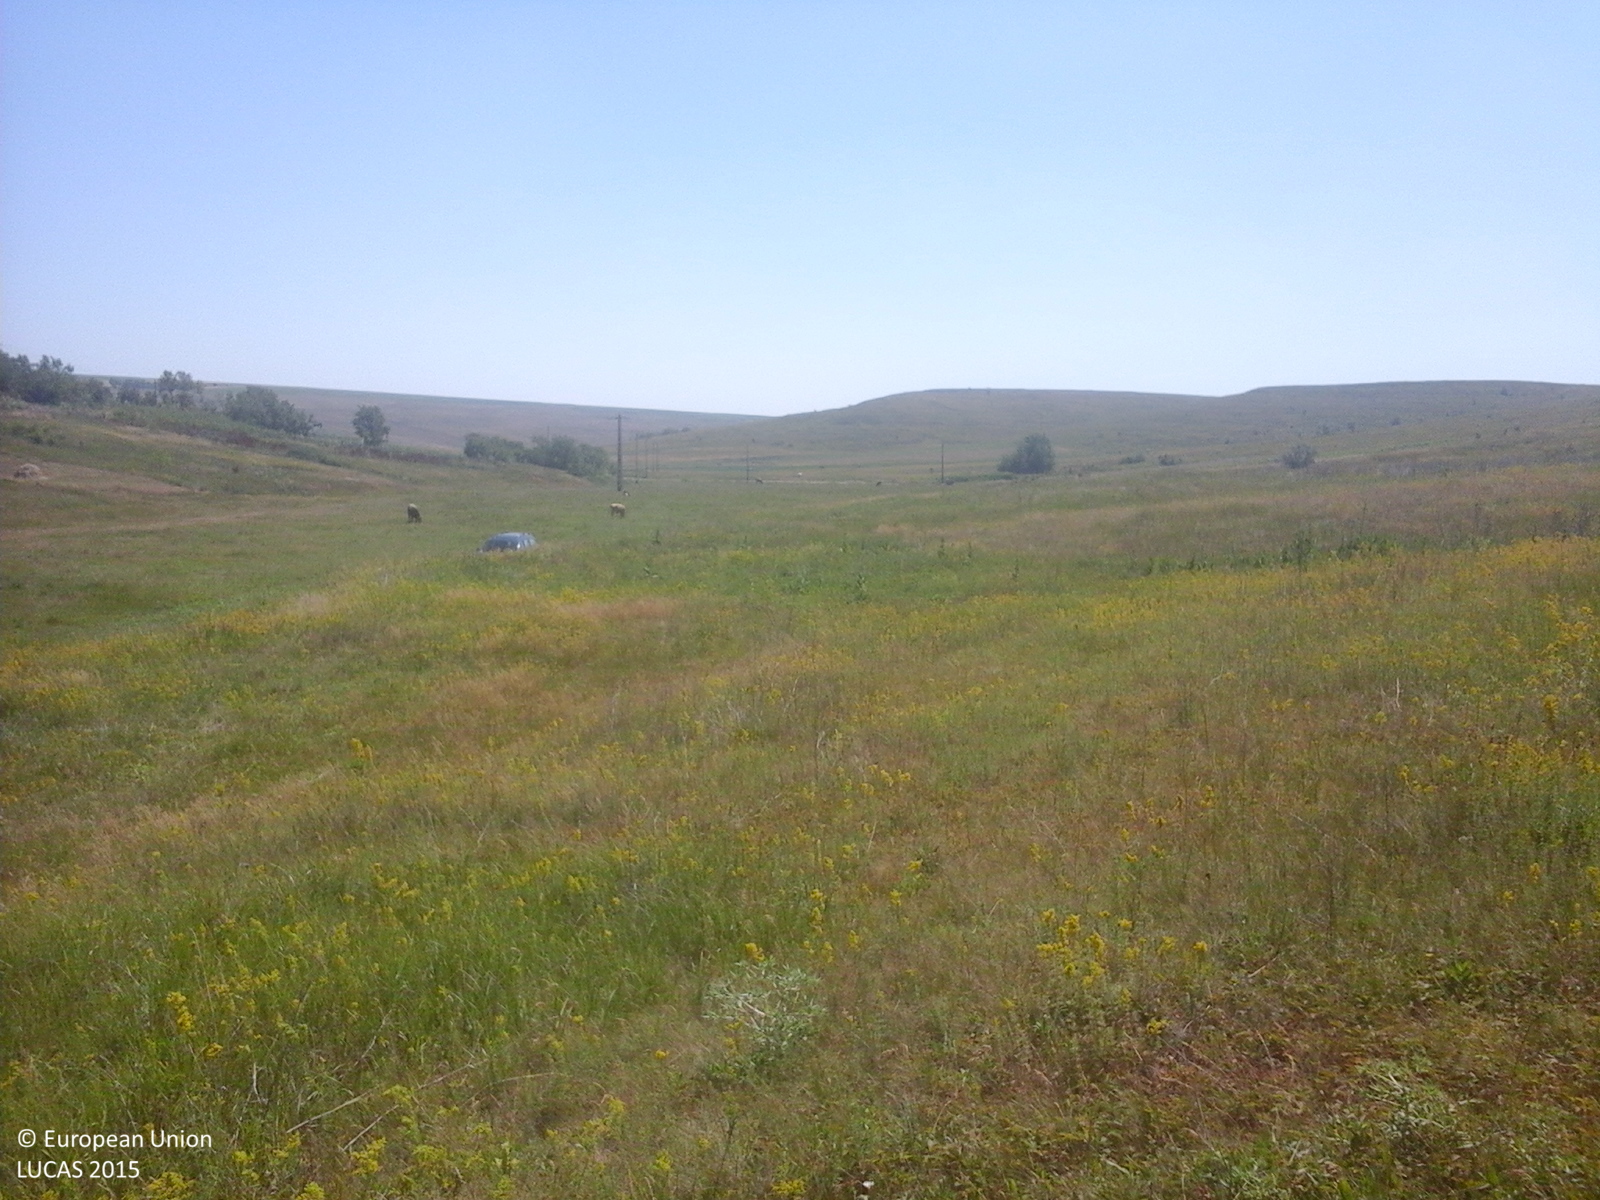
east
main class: Grassland
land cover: Grassland without tree/shrub cover
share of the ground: > 75 %
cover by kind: herbaceous plants 100 %
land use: Agriculture (excluding fallow land and kitchen gardens)
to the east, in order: Grassland without tree/shrub cover
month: June
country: RO
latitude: 47.7954
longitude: 26.8552
